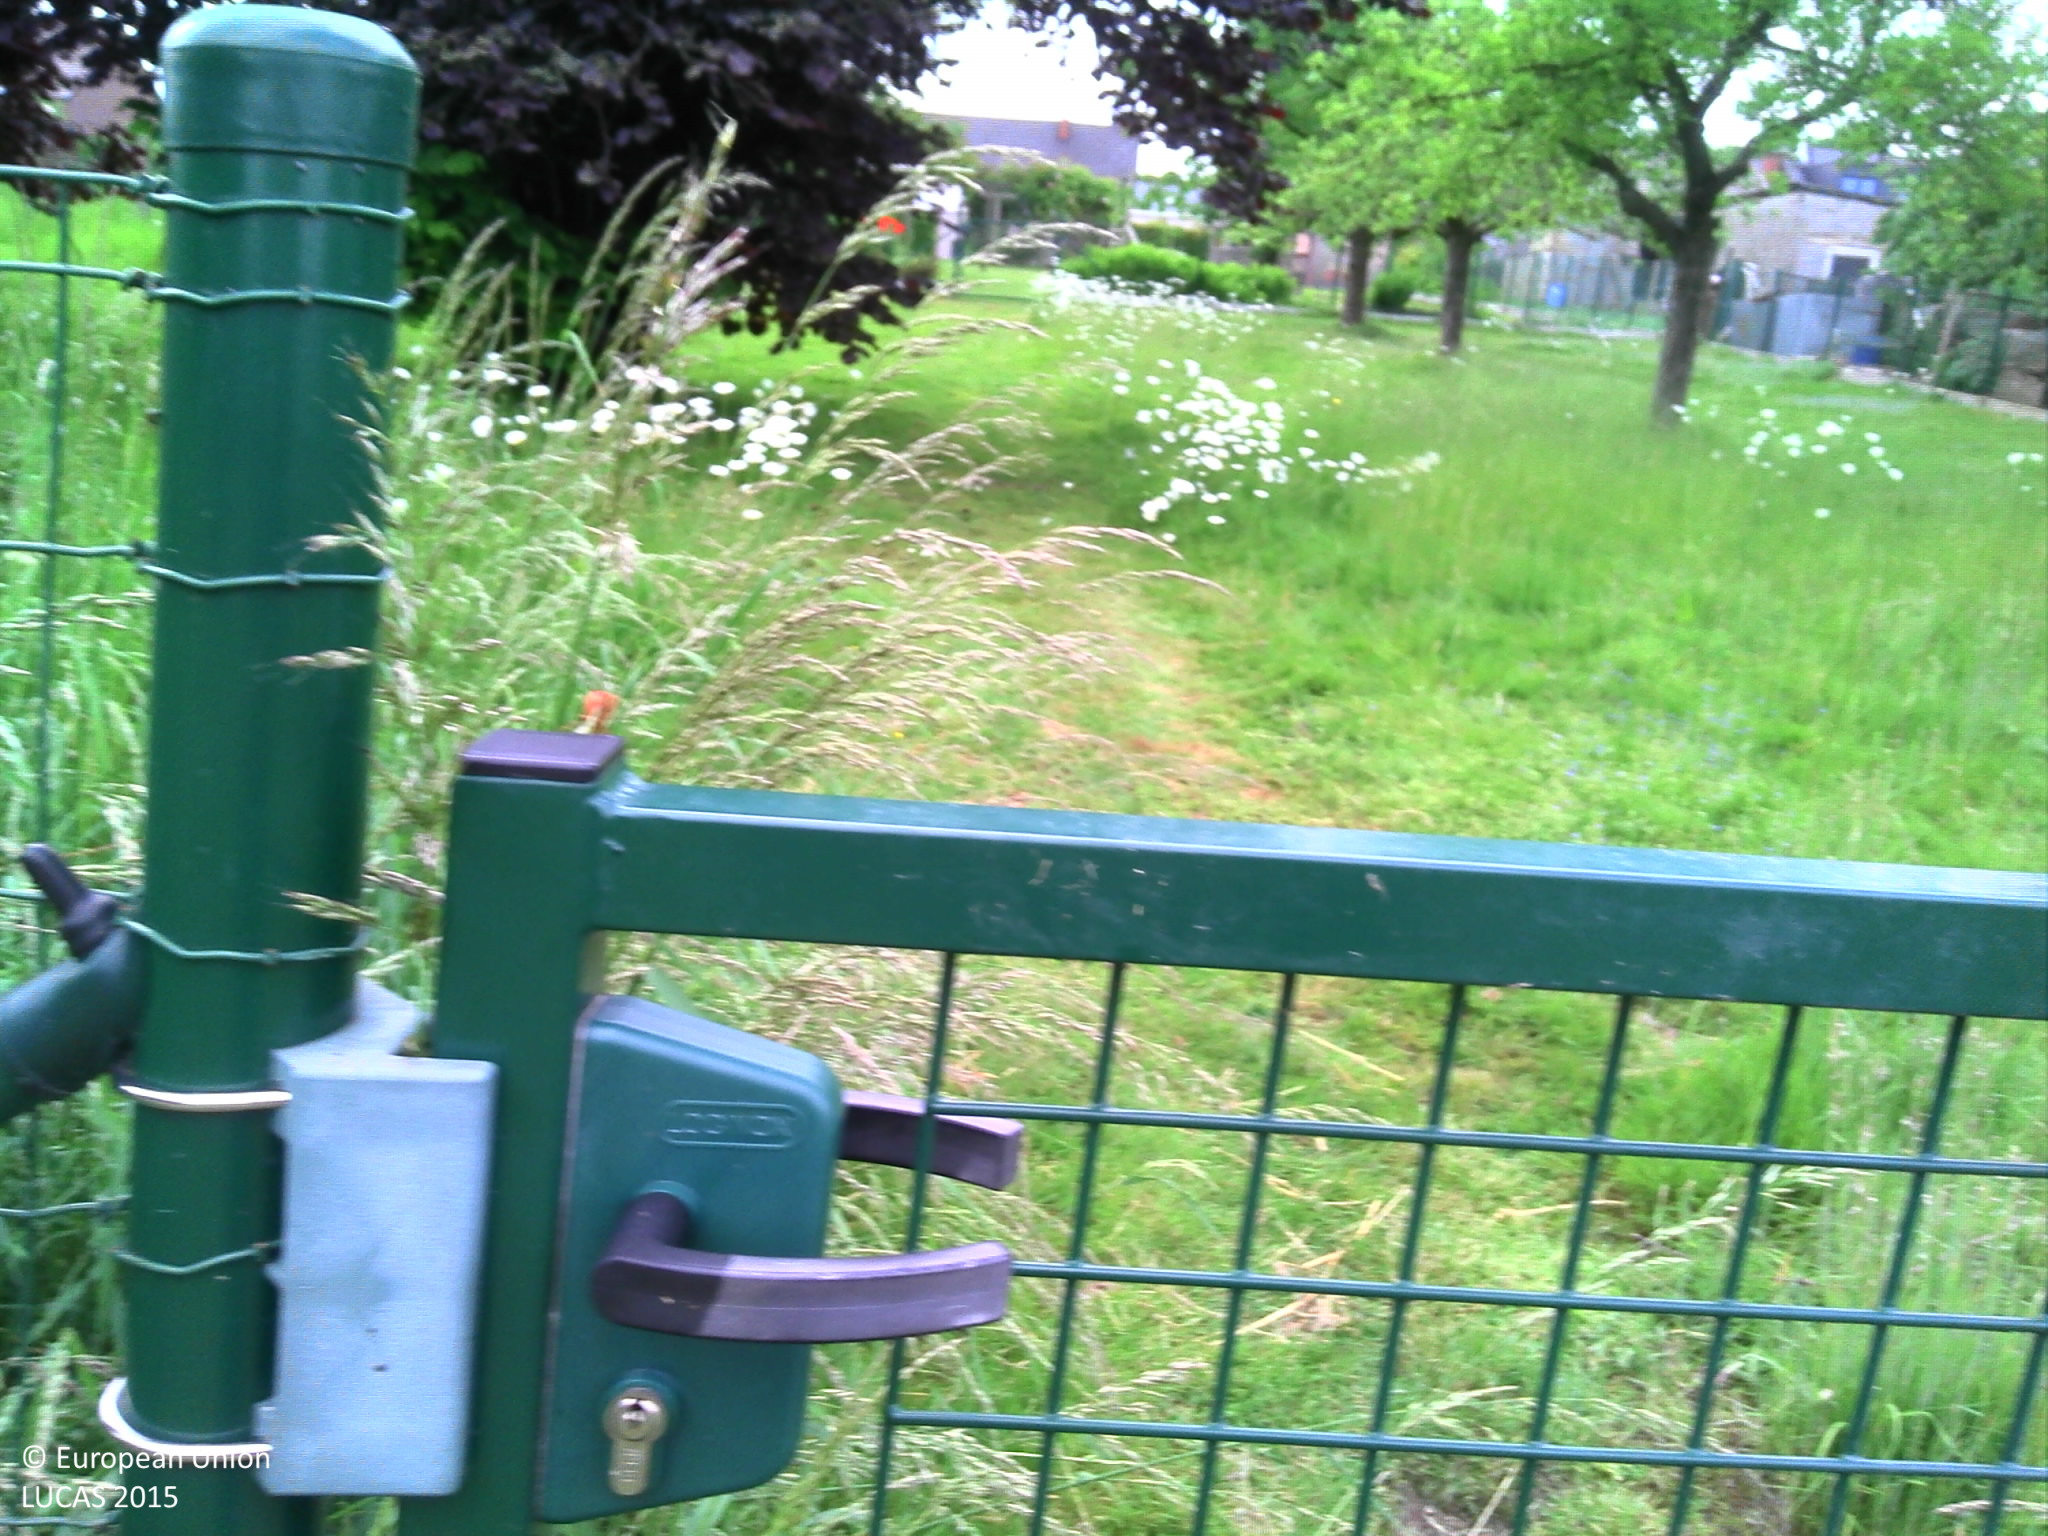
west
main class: Grassland
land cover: Grassland with sparse tree/shrub cover
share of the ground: > 75 %
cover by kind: herbaceous plants 95 %, broadleaved forest trees 5 %
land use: Residential
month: June
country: BE
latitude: 50.7594
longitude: 3.8837
